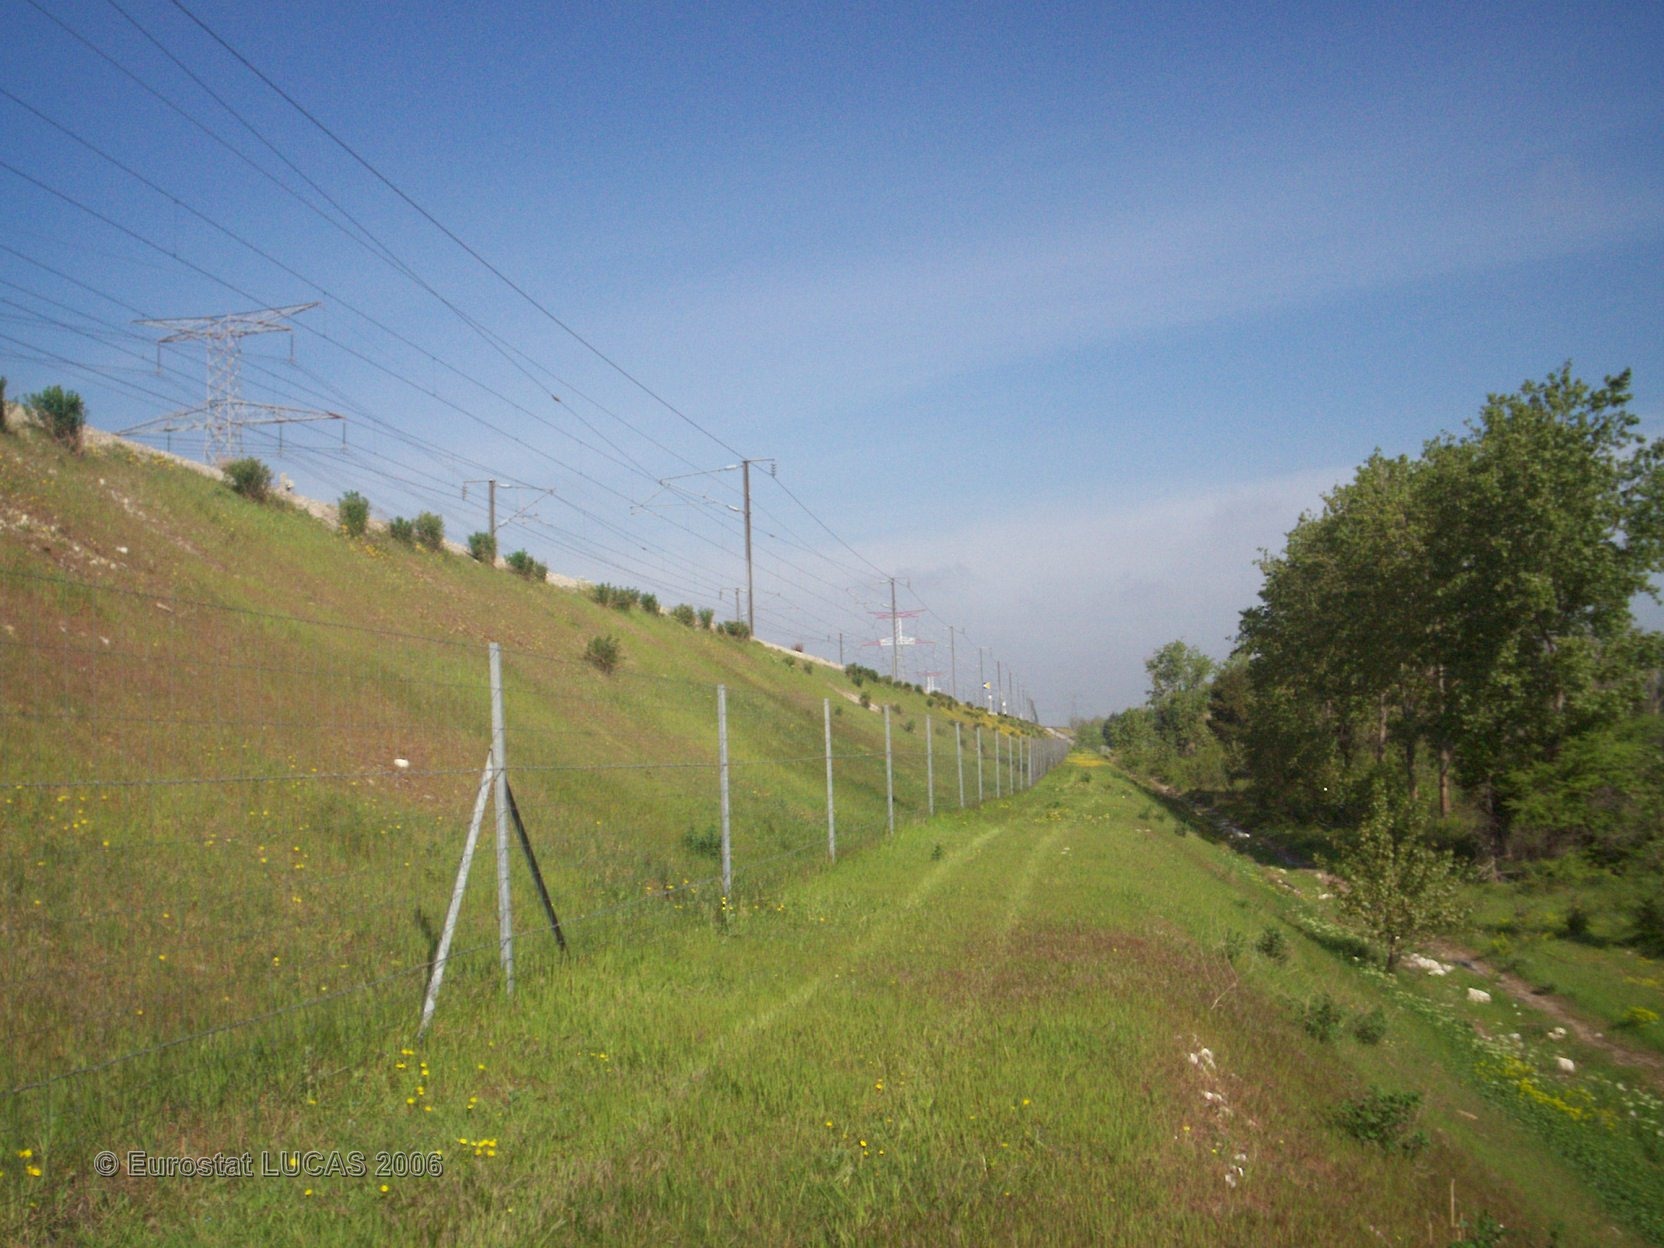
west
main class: Grassland
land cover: Grassland without tree/shrub cover
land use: Railway transport
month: April
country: FR
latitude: 43.7988
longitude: 5.0499
